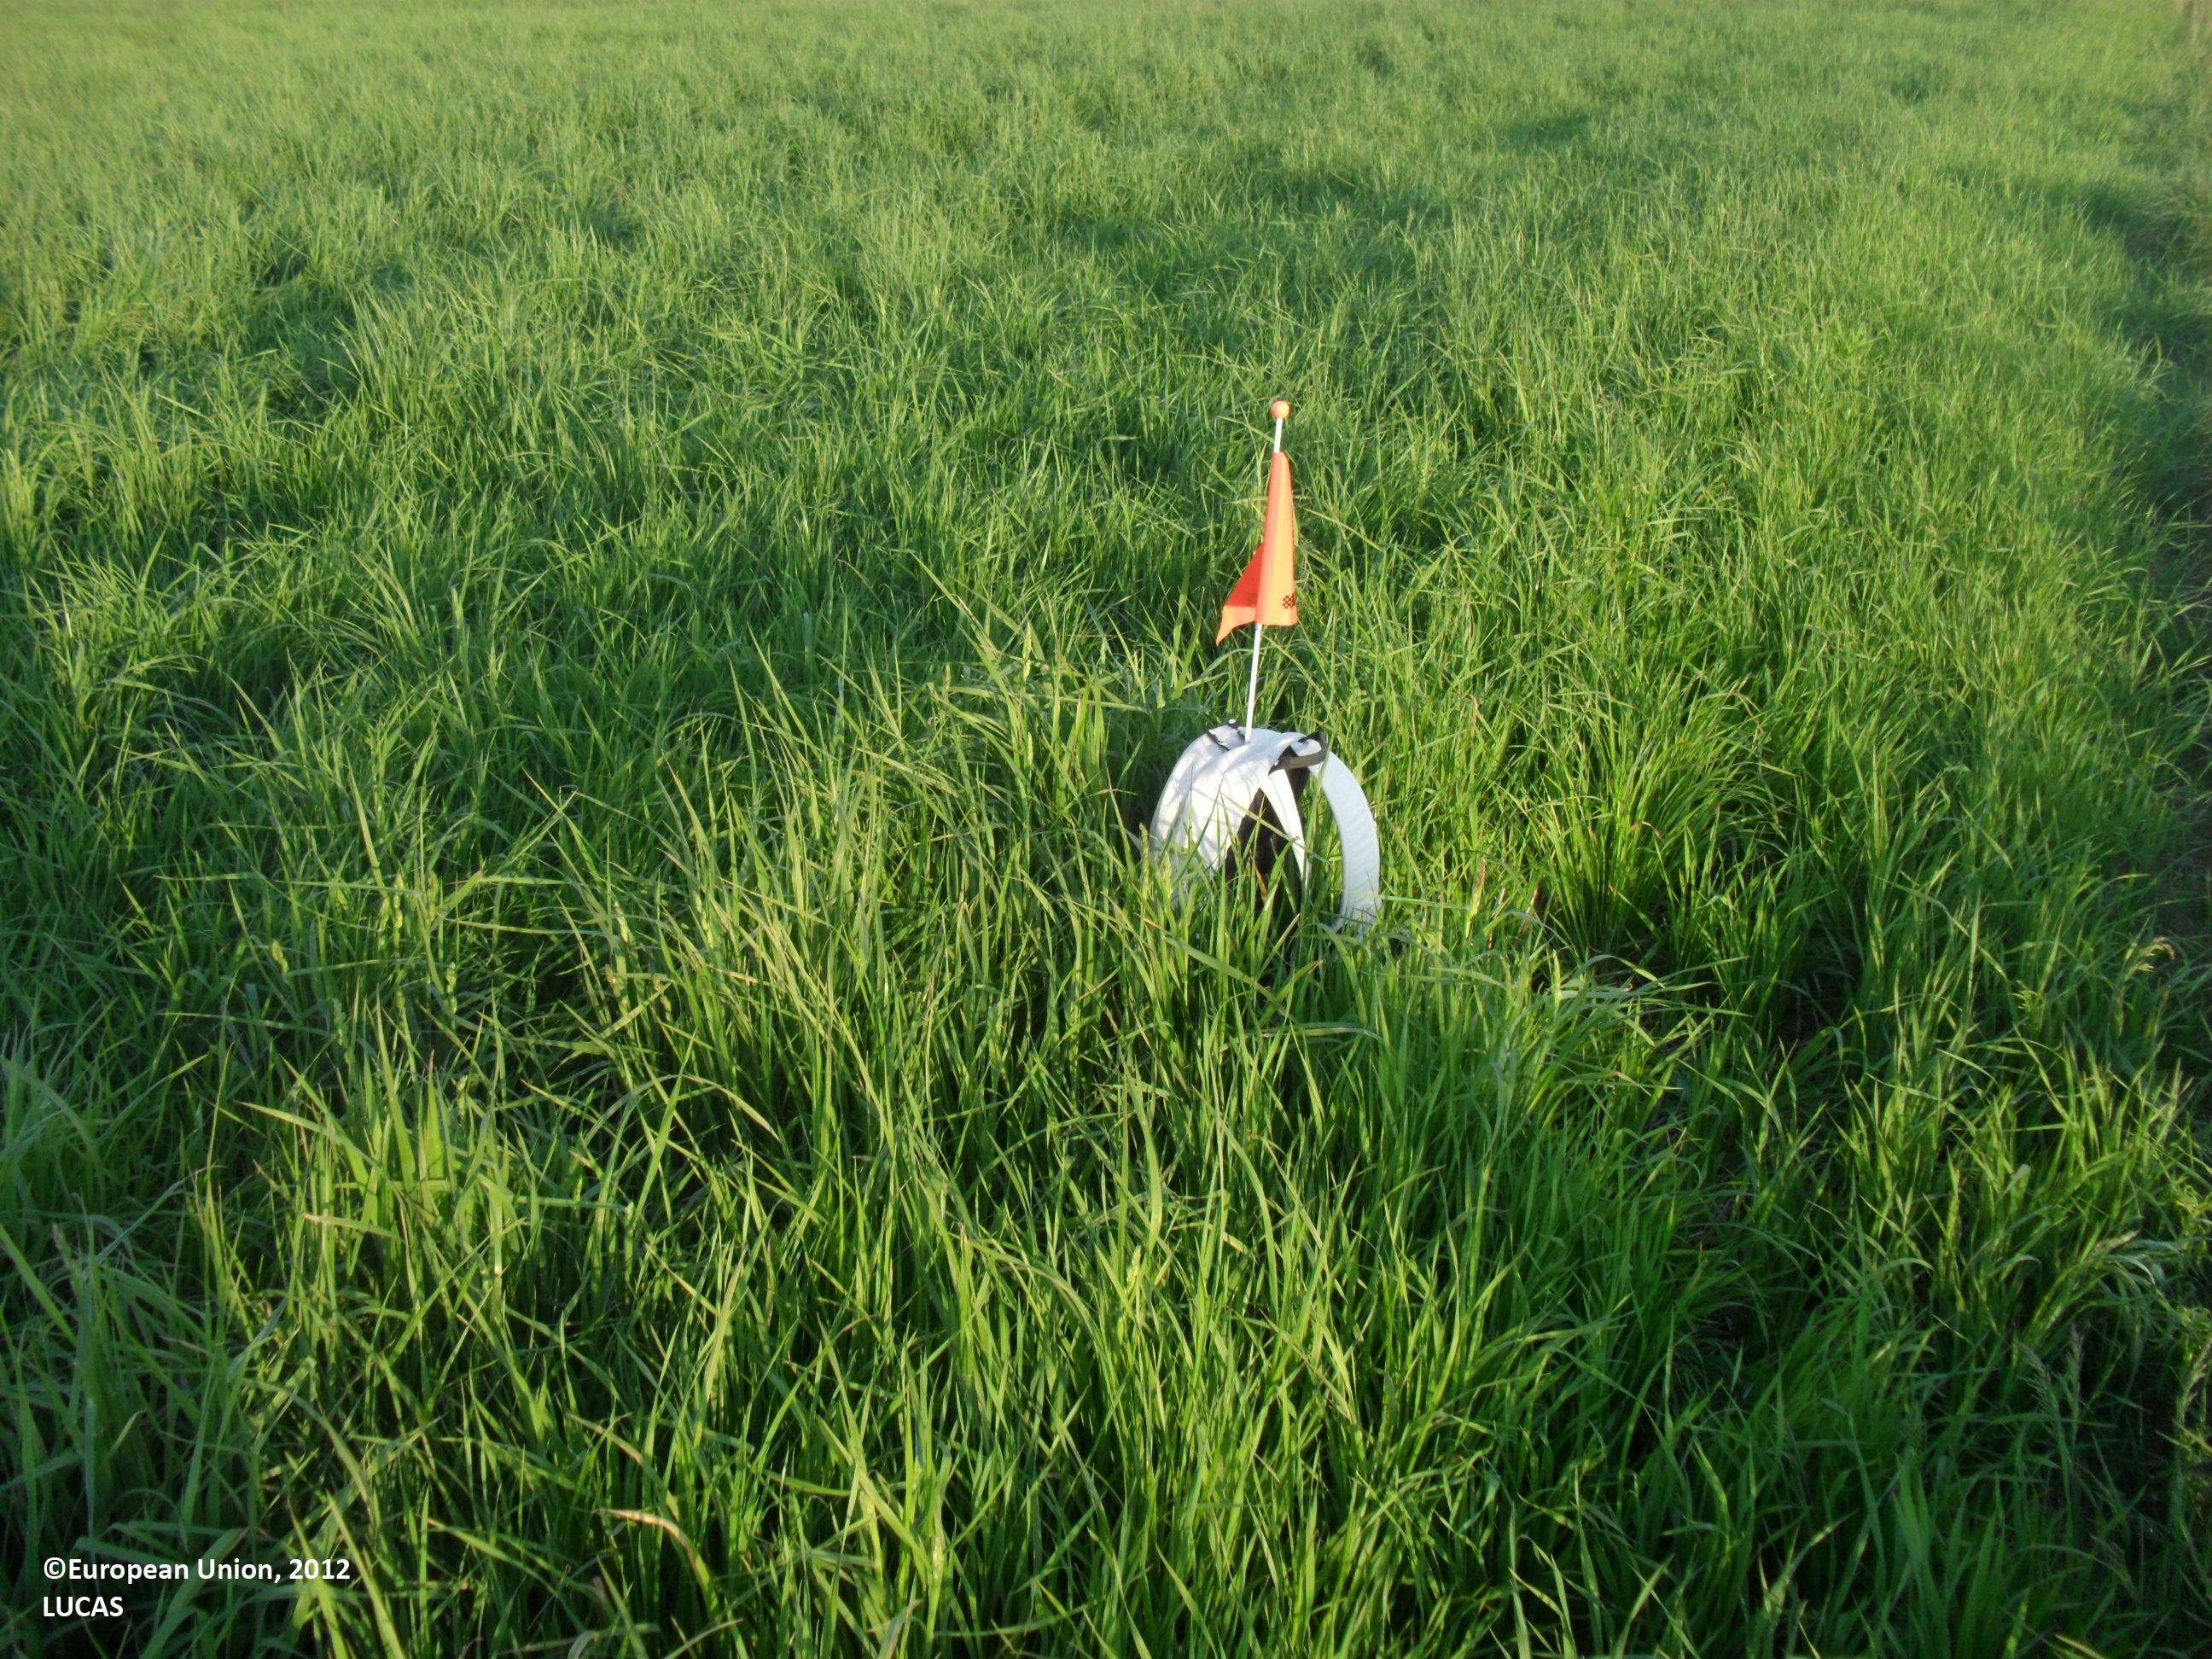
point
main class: Cropland
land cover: Temporary grasslands
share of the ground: > 75 %
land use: Agriculture (excluding fallow land and kitchen gardens)
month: June
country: FI
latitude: 62.9088
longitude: 23.1906
